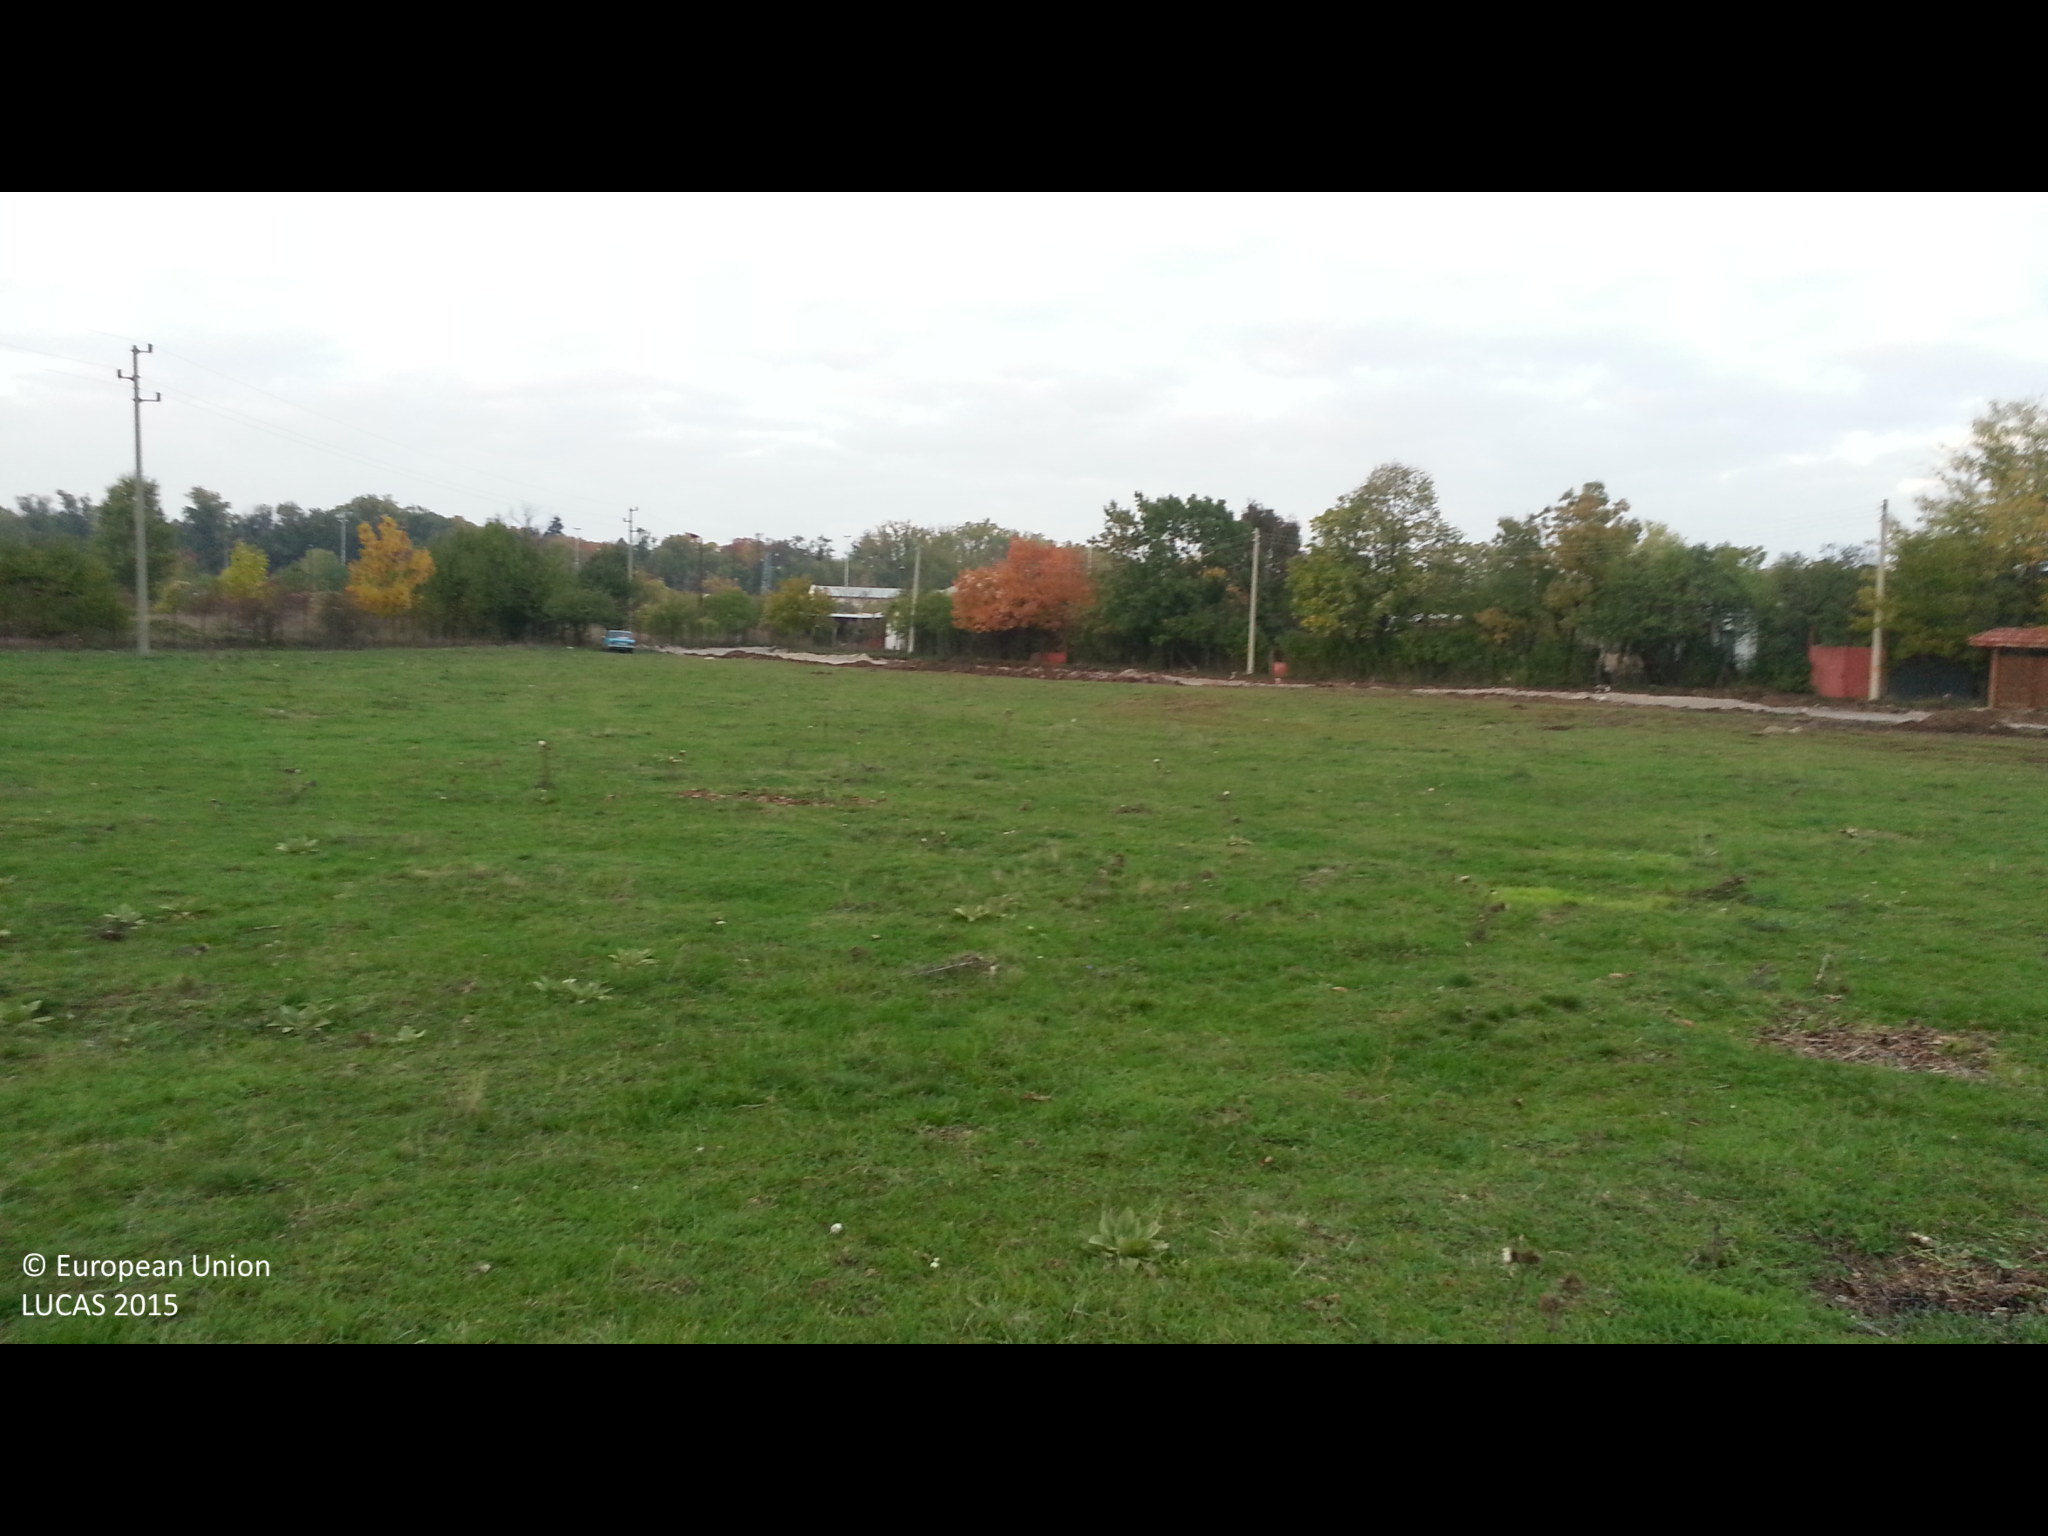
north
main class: Grassland
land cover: Grassland without tree/shrub cover
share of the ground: > 75 %
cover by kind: herbaceous plants 100 %
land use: Agriculture (excluding fallow land and kitchen gardens)
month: October
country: BG
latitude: 42.6316
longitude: 23.4367
